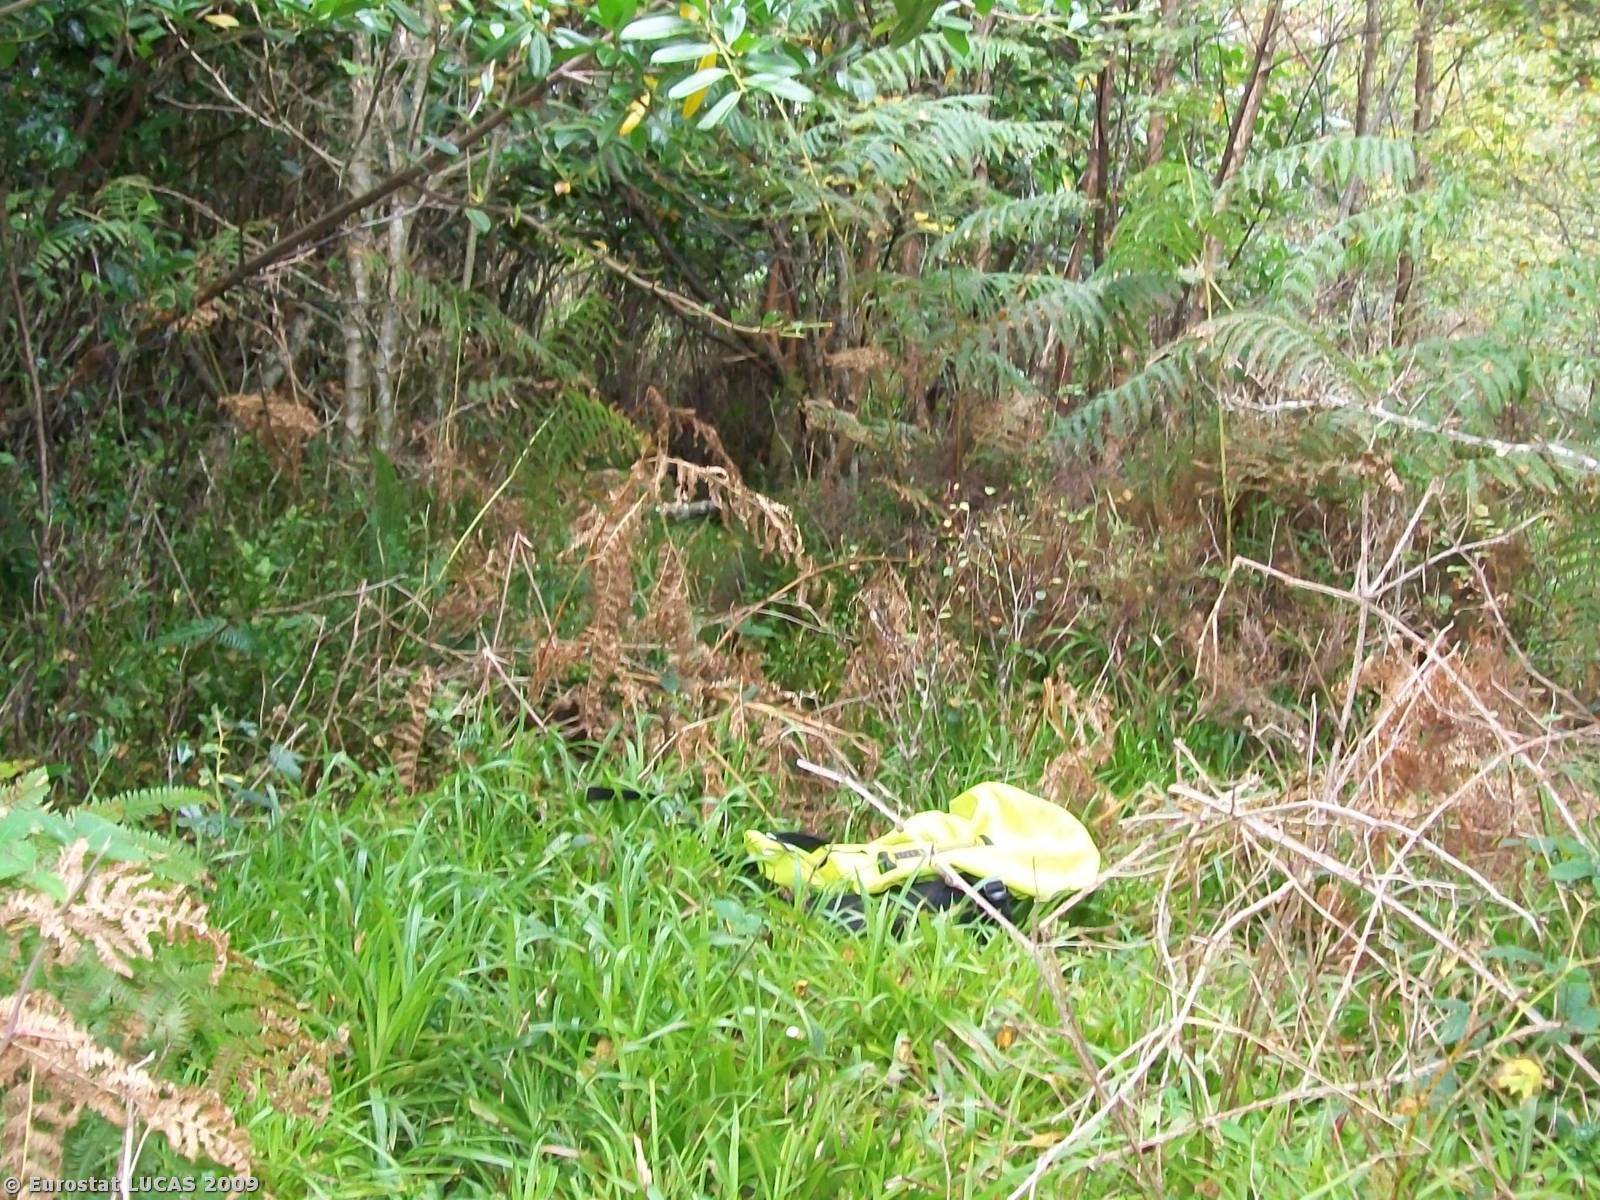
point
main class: Woodland
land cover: Broadleaved woodland
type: acidophilous oak and oak-birch forest
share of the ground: > 75 %
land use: Forestry
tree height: > 5 m
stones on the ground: < 10 %
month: September
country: IE
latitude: 53.0664
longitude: -8.3811
